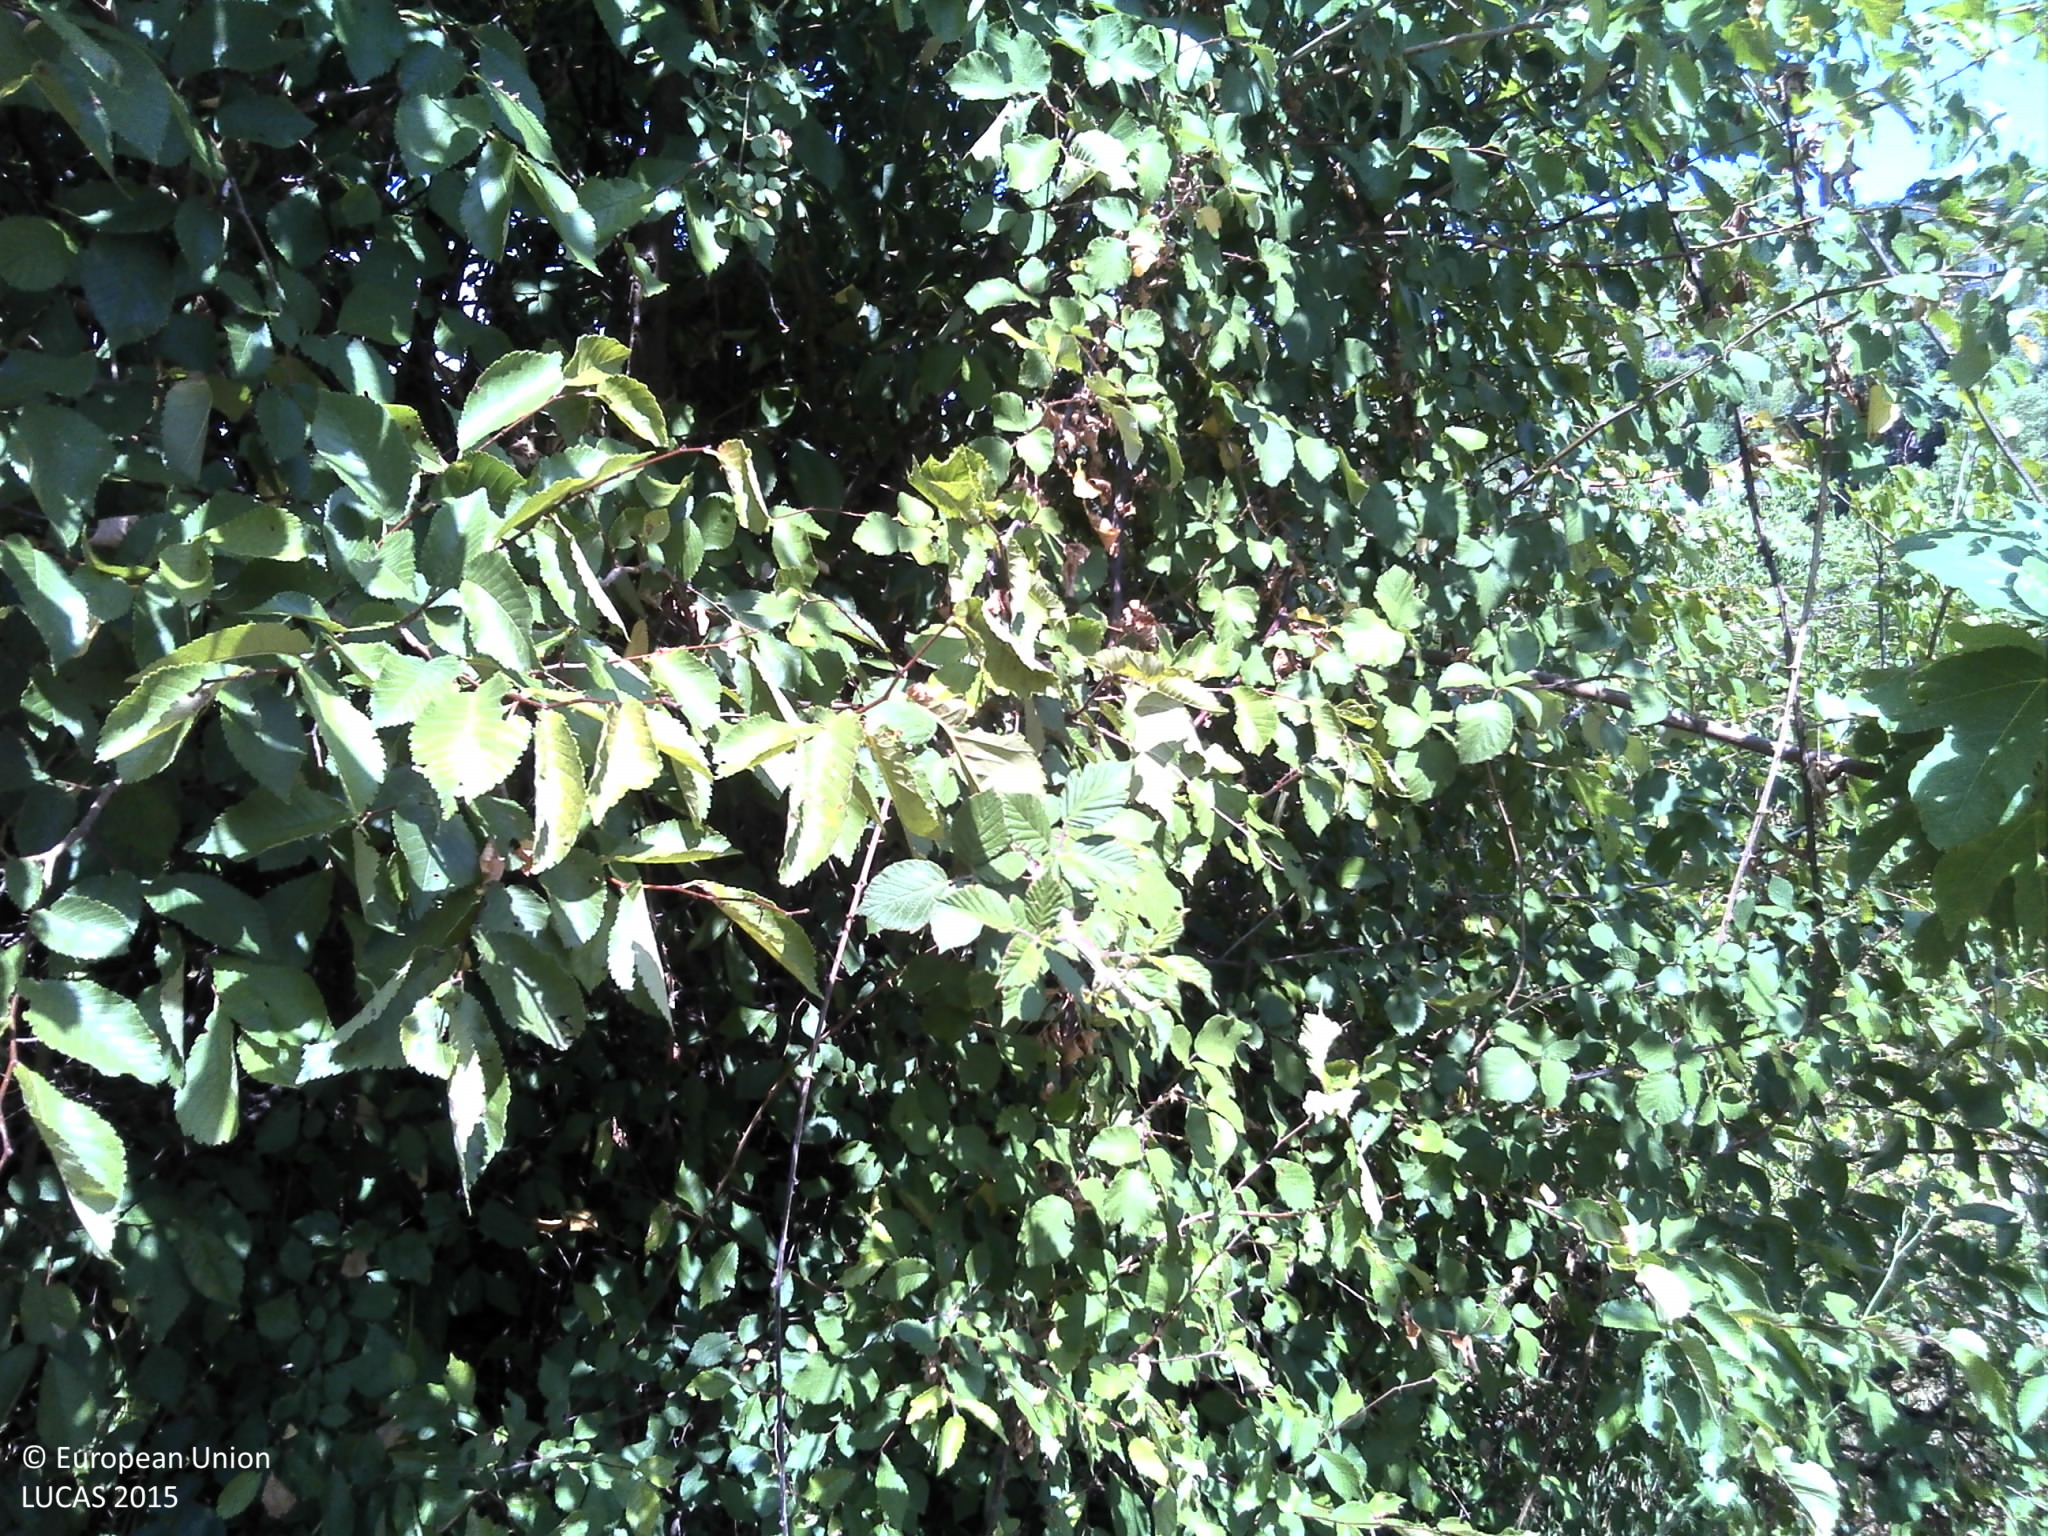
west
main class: Grassland
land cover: Grassland with sparse tree/shrub cover
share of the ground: > 75 %
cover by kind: herbaceous plants 85 %, shrubs 10 %, broadleaved forest trees 5 %
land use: Abandoned areas
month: July
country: HR
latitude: 43.4701
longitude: 17.1491
